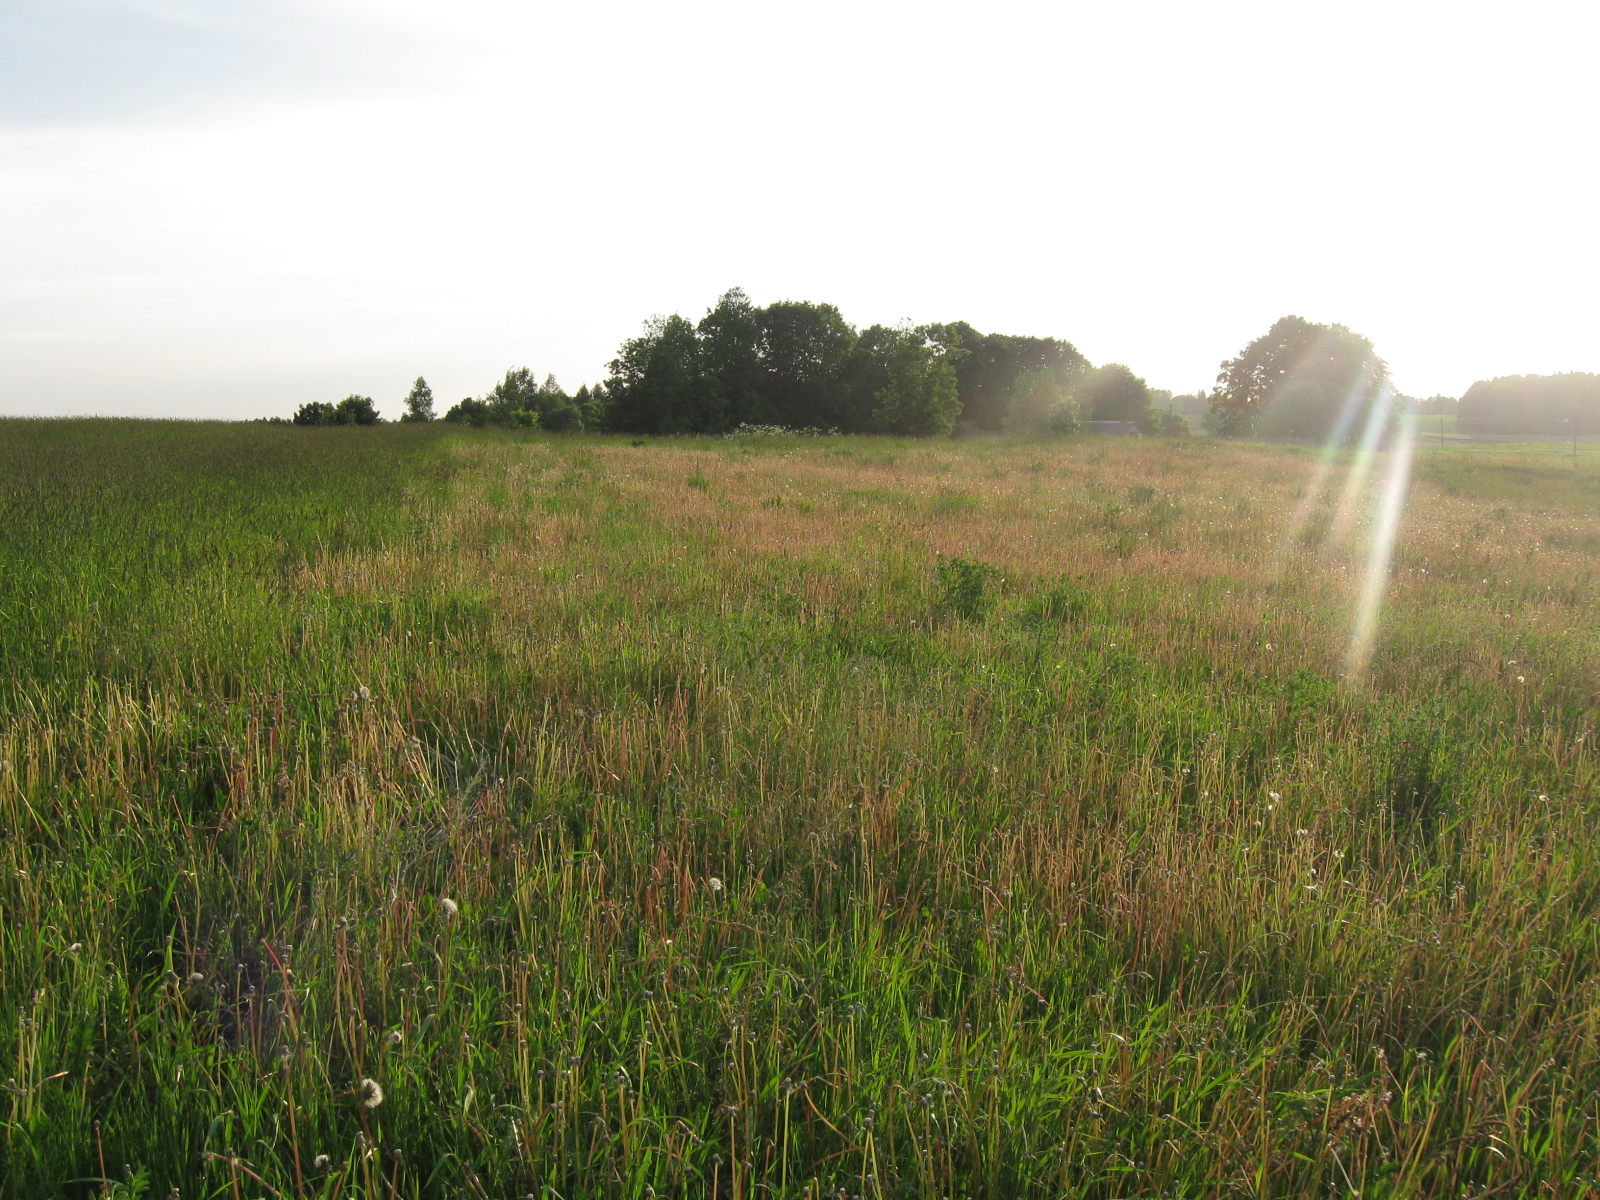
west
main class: Grassland
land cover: Grassland without tree/shrub cover
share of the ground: > 75 %
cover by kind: herbaceous plants 100 %
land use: Agriculture (excluding fallow land and kitchen gardens)
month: June
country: LT
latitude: 54.2533
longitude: 23.6070
